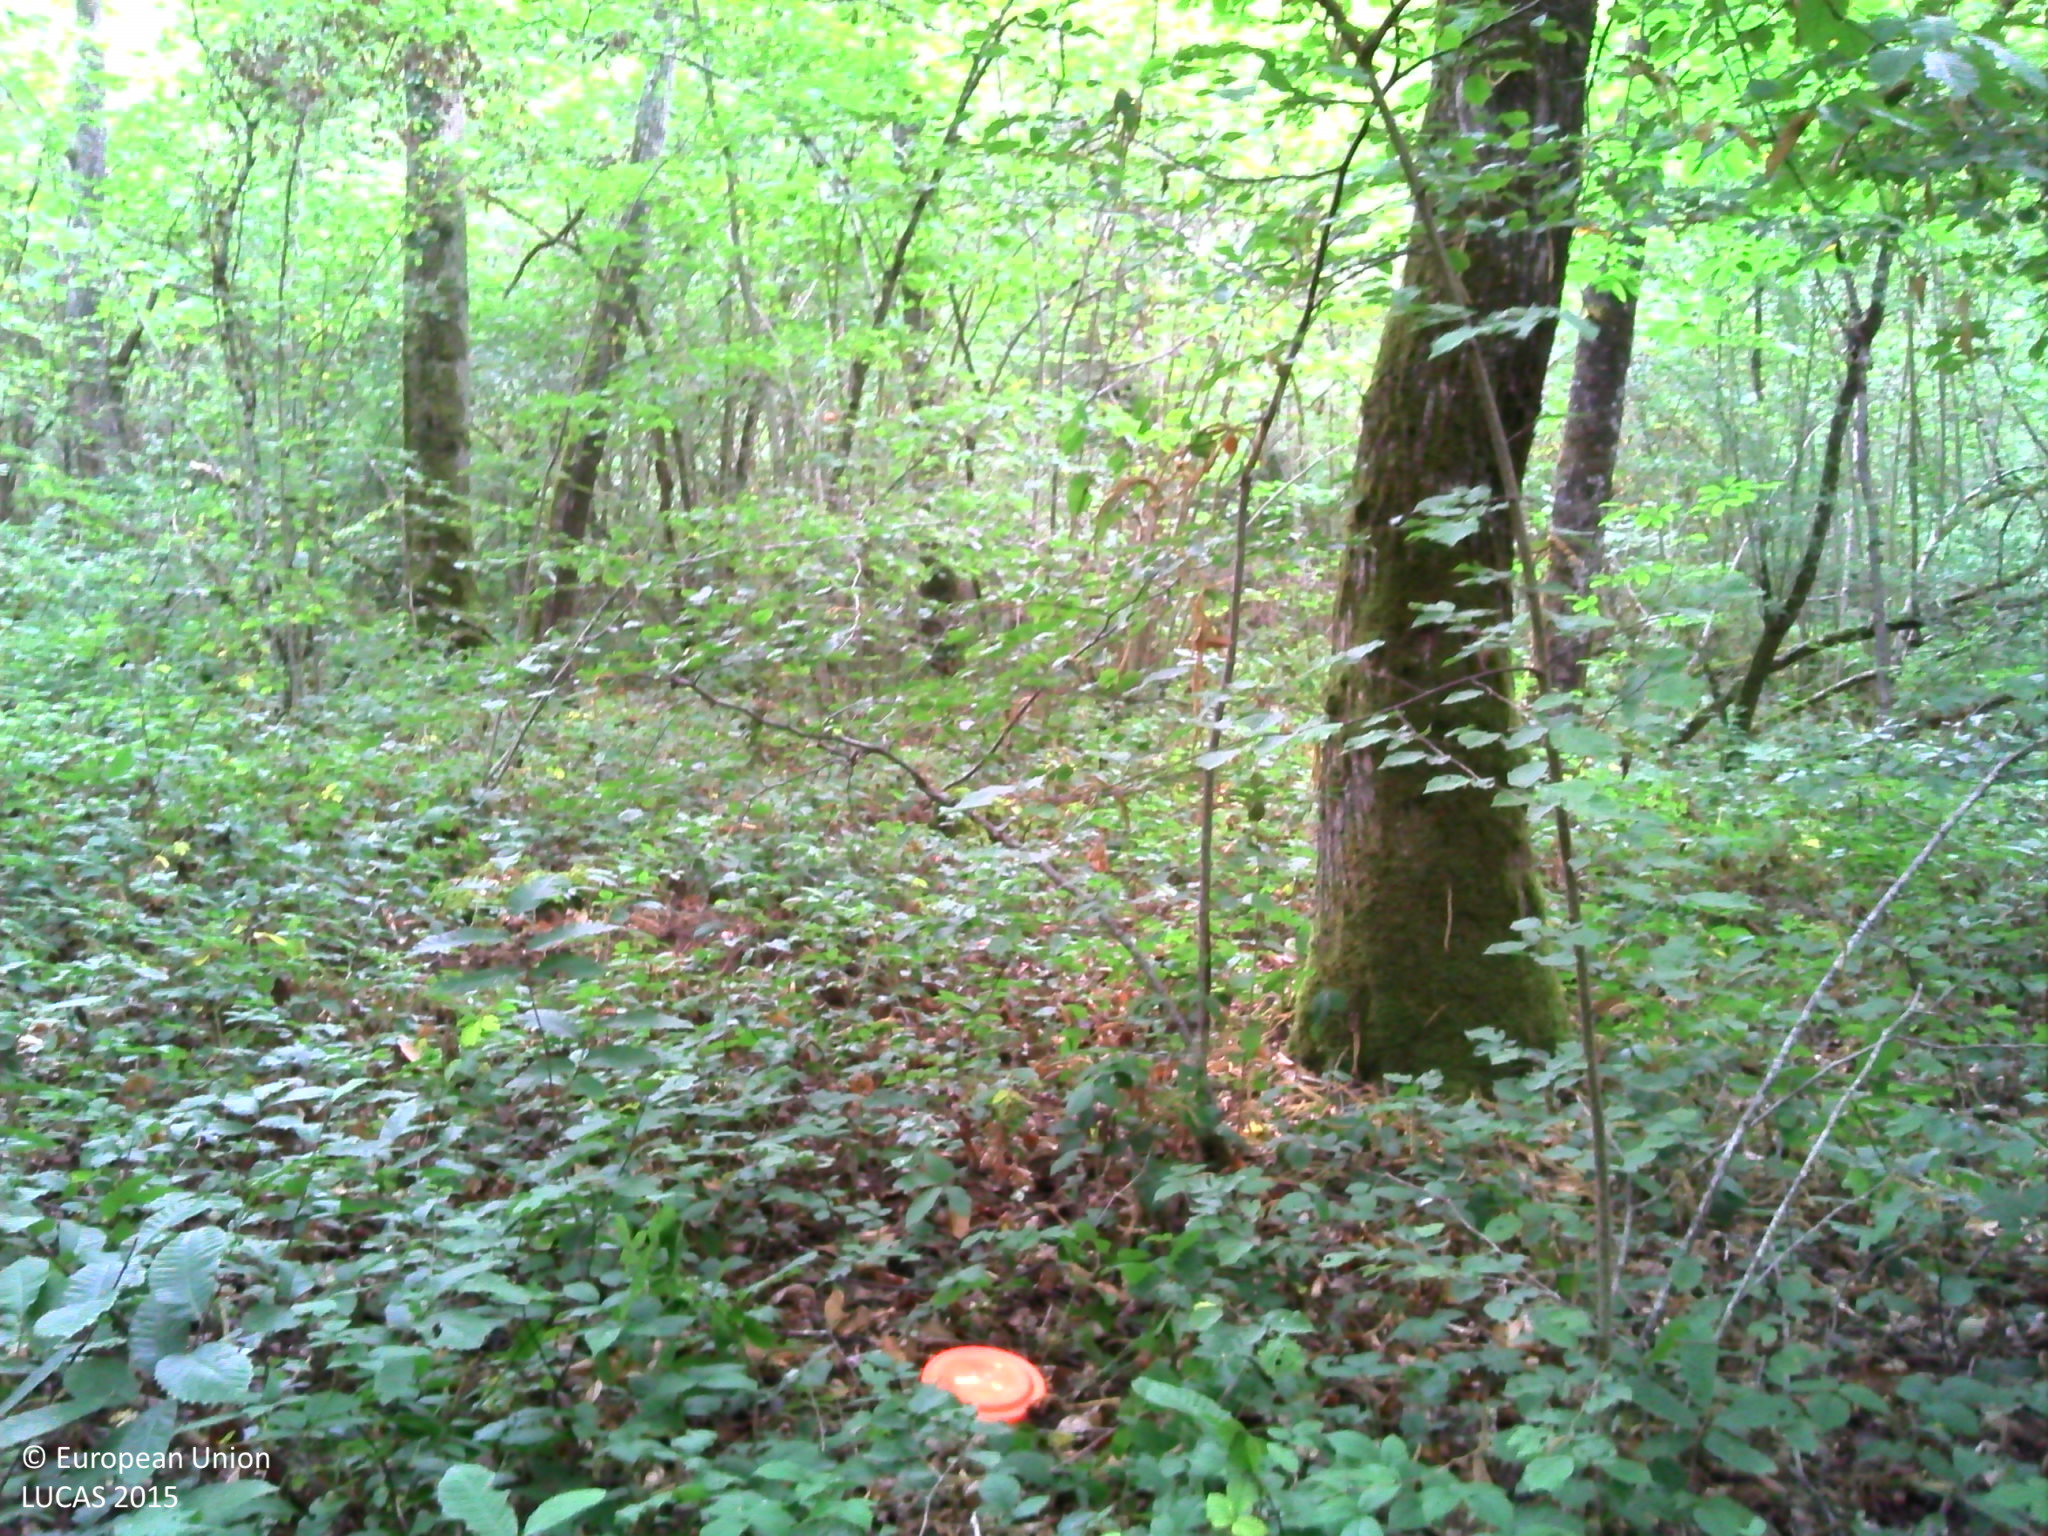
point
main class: Woodland
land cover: Broadleaved woodland
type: mesophytic deciduous forest
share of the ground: > 75 %
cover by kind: broadleaved forest trees 90 %, herbaceous plants 5 %, lichens and mosses 5 %
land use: Forestry
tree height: > 5 m
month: July
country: FR
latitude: 48.1354
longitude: 3.4233
